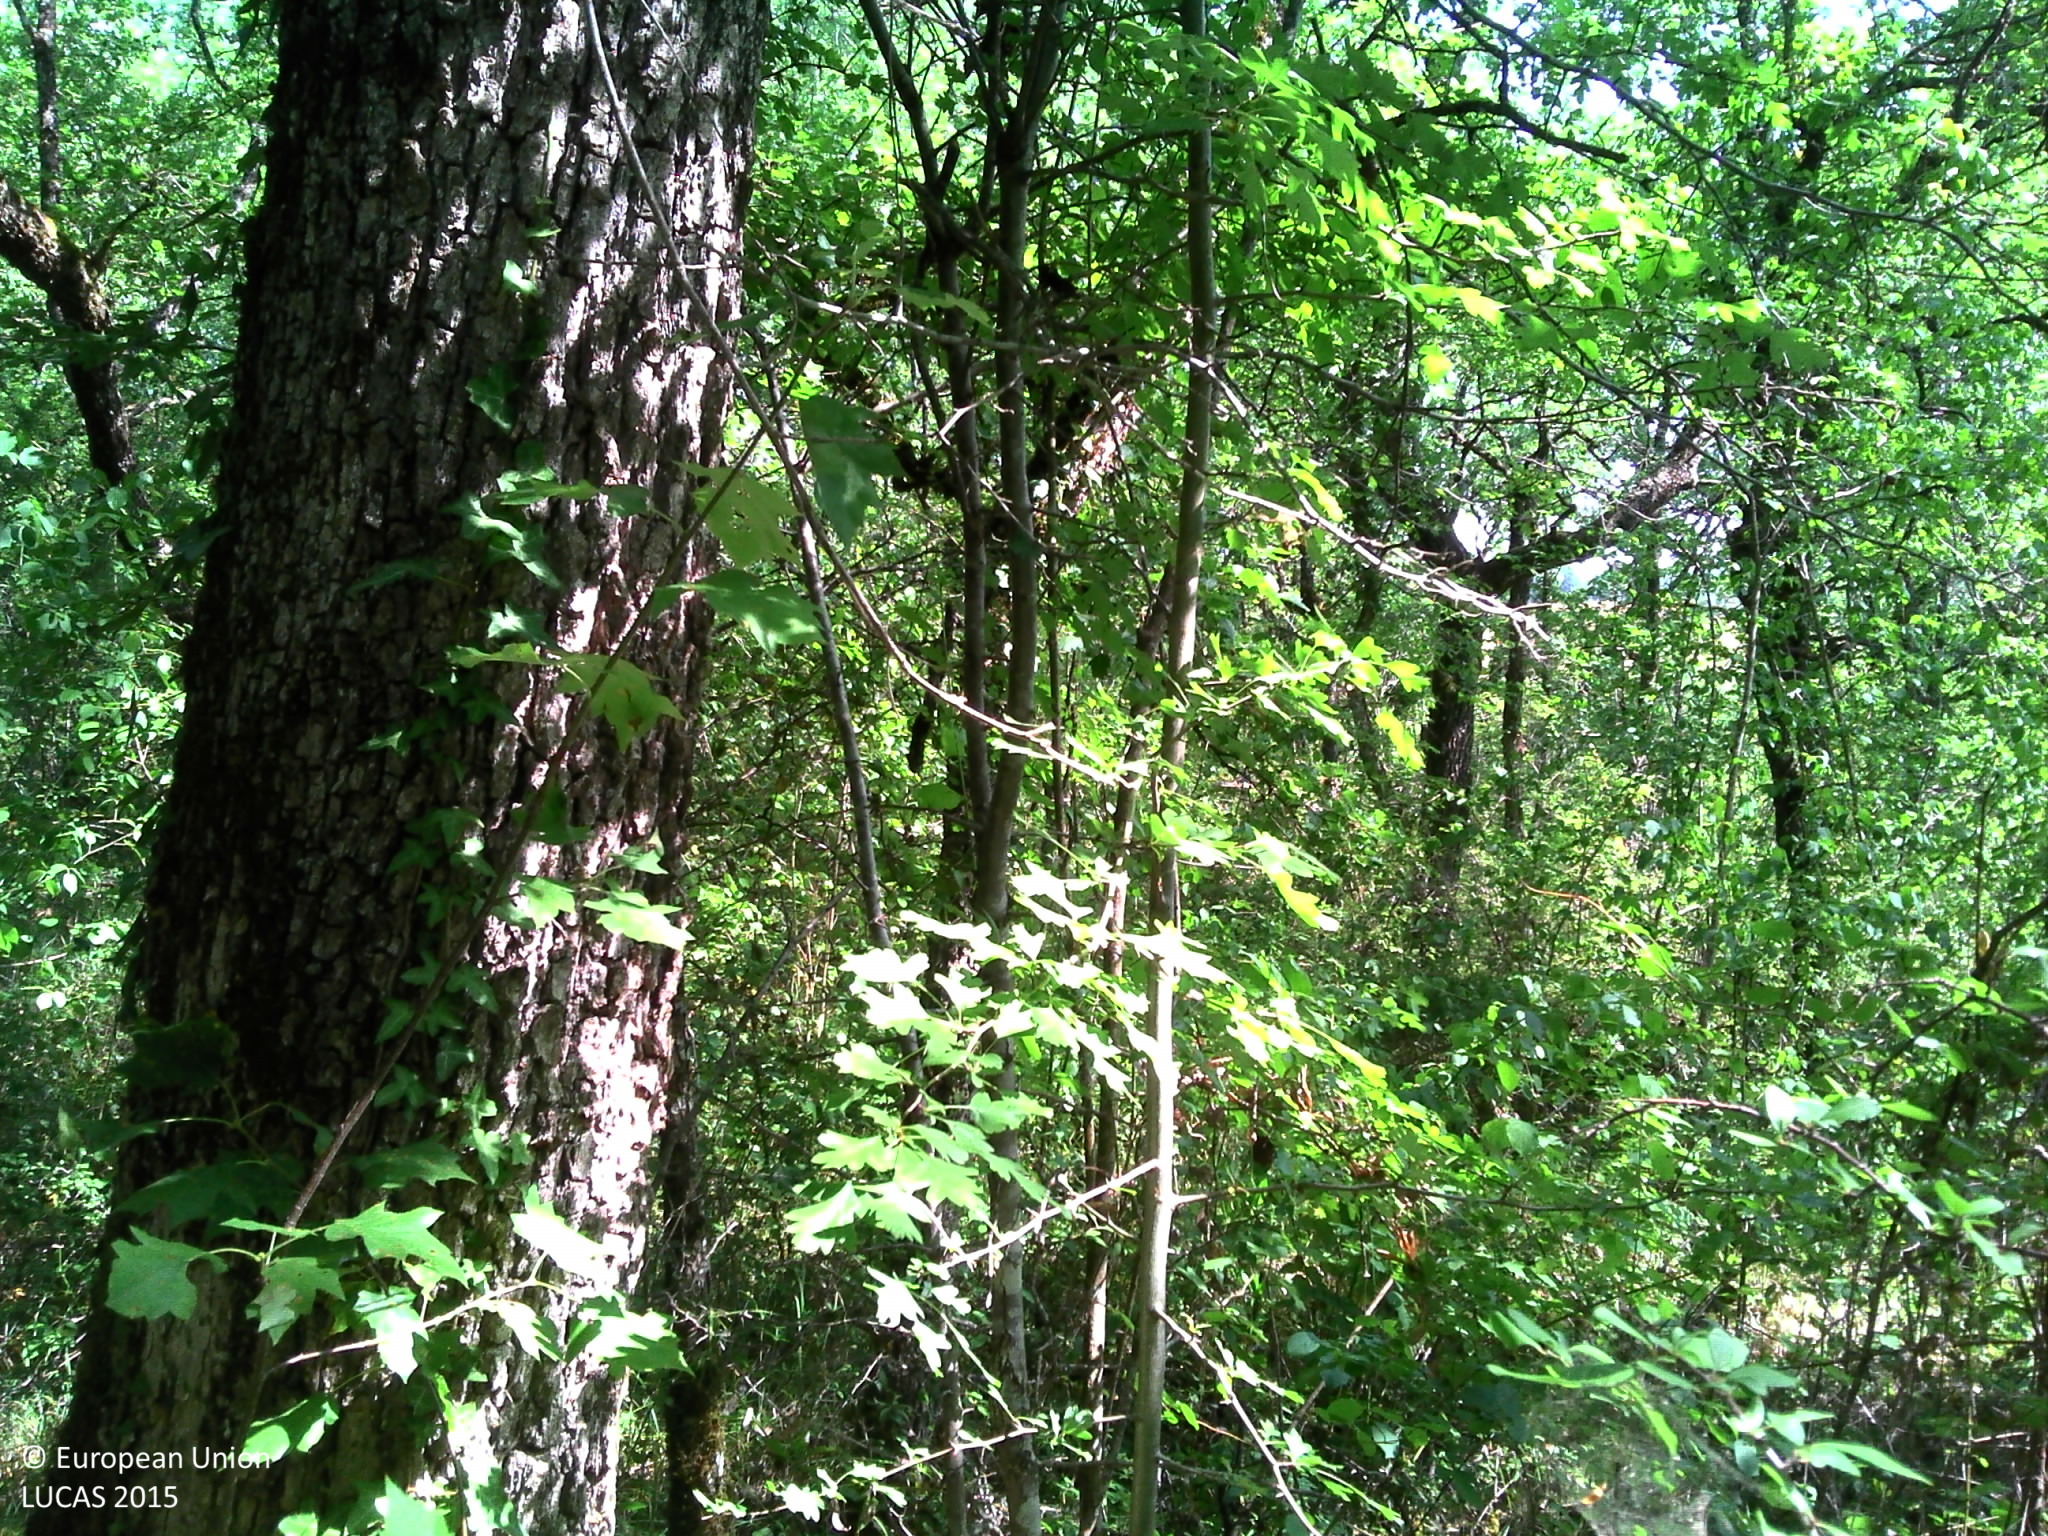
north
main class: Woodland
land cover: Broadleaved woodland
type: thermophilous deciduous forest
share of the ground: > 75 %
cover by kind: broadleaved forest trees 95 %, coniferous forest trees 5 %
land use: Forestry
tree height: > 5 m
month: July
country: FR
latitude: 44.5302
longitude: 0.8968
